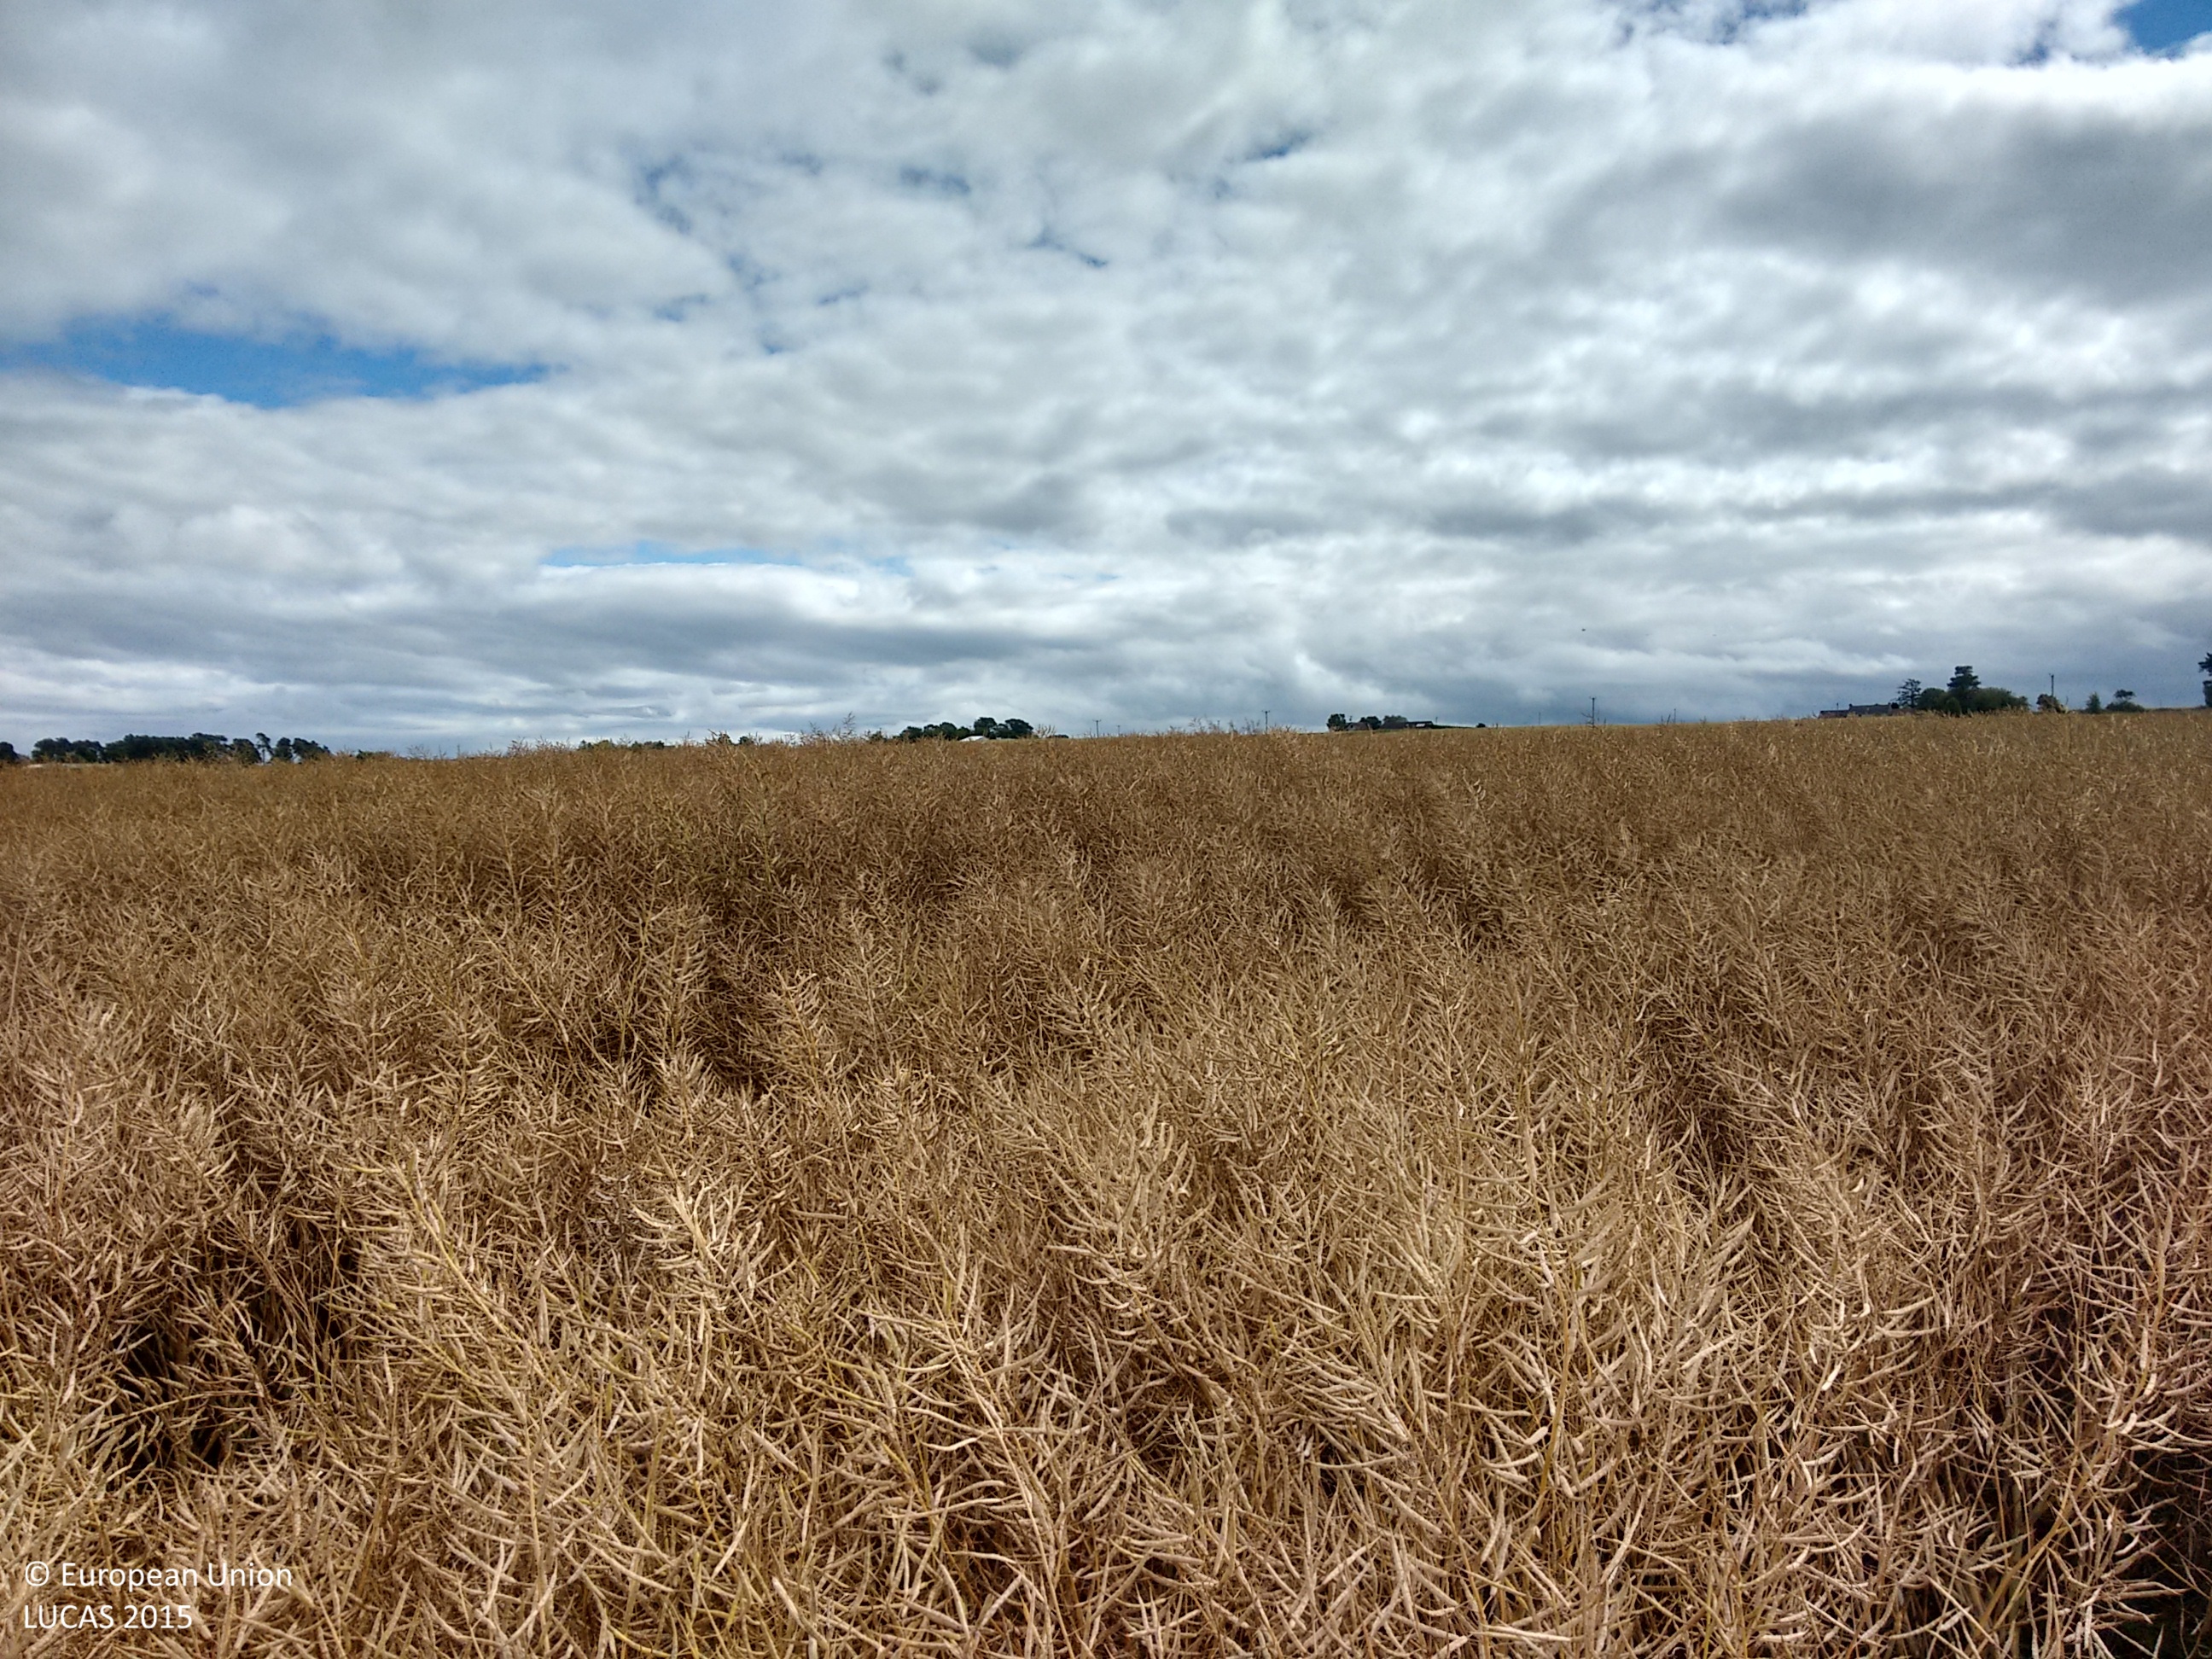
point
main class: Cropland
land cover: Rape and turnip rape
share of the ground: > 75 %
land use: Agriculture (excluding fallow land and kitchen gardens)
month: August
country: GB
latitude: 57.6565
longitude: -4.2460
